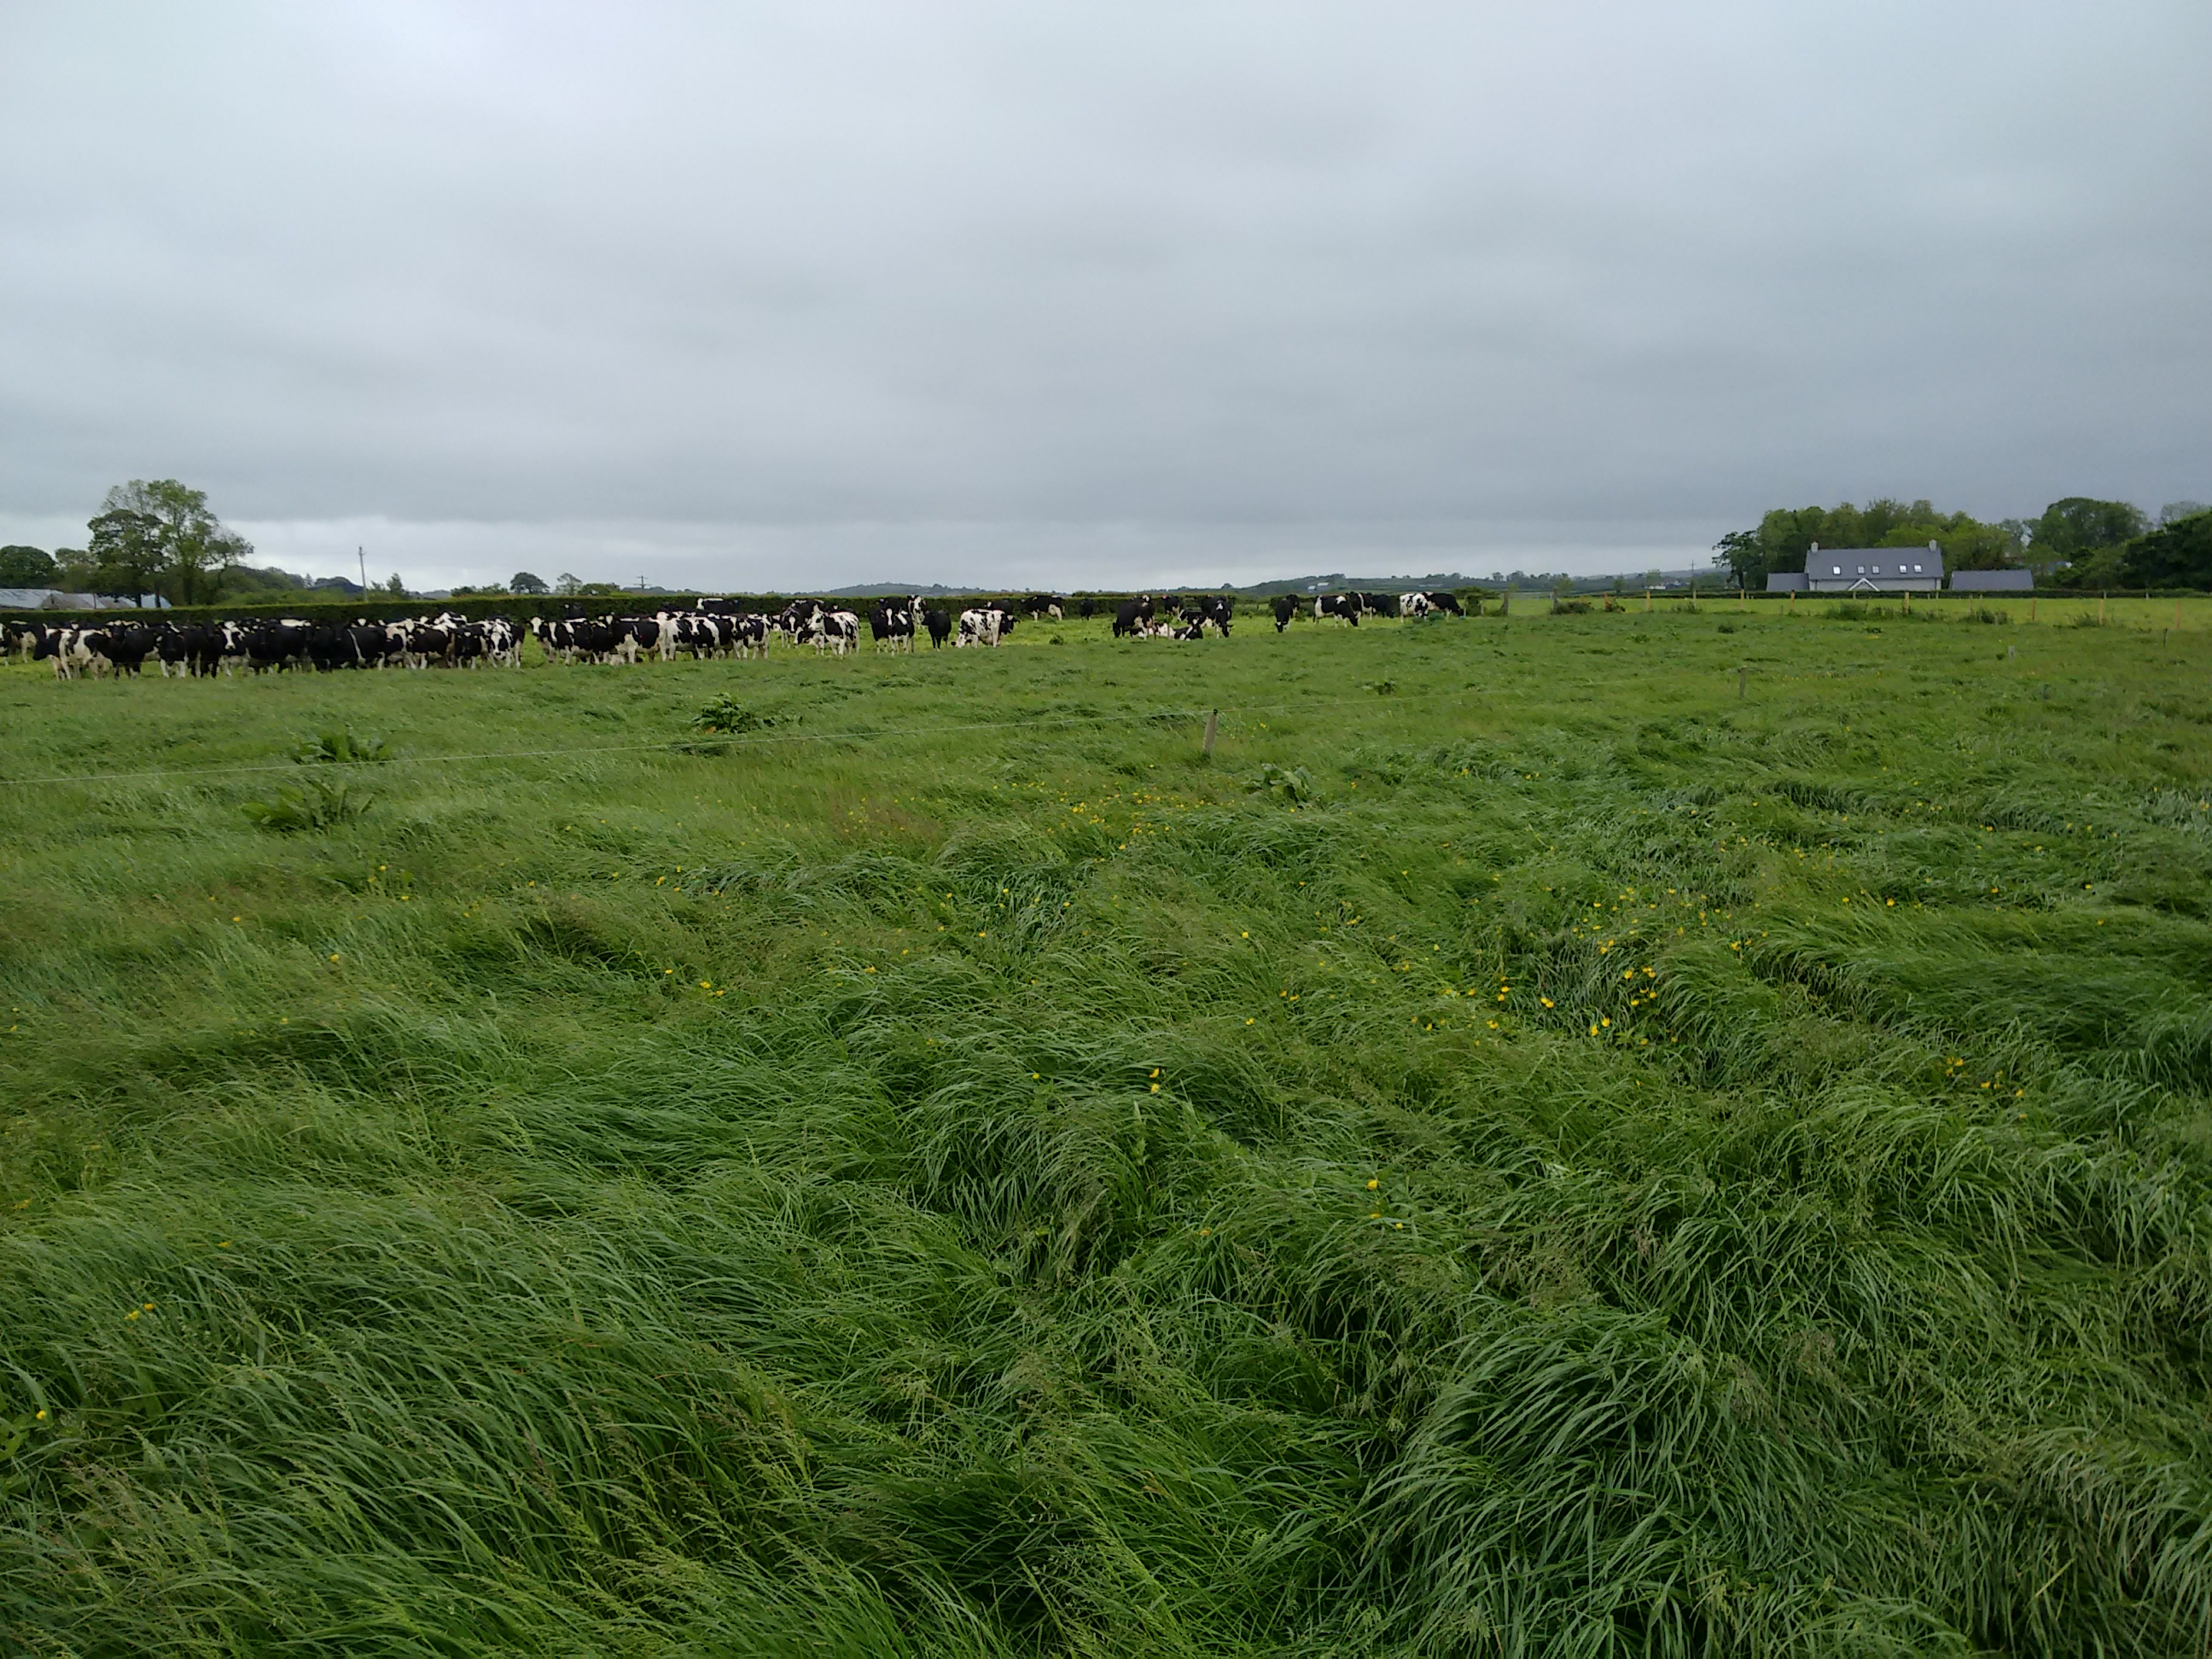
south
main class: Grassland
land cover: Grassland without tree/shrub cover
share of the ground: > 75 %
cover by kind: herbaceous plants 100 %
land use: Agriculture (excluding fallow land and kitchen gardens)
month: June
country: GB
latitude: 55.0177
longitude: -6.6264
